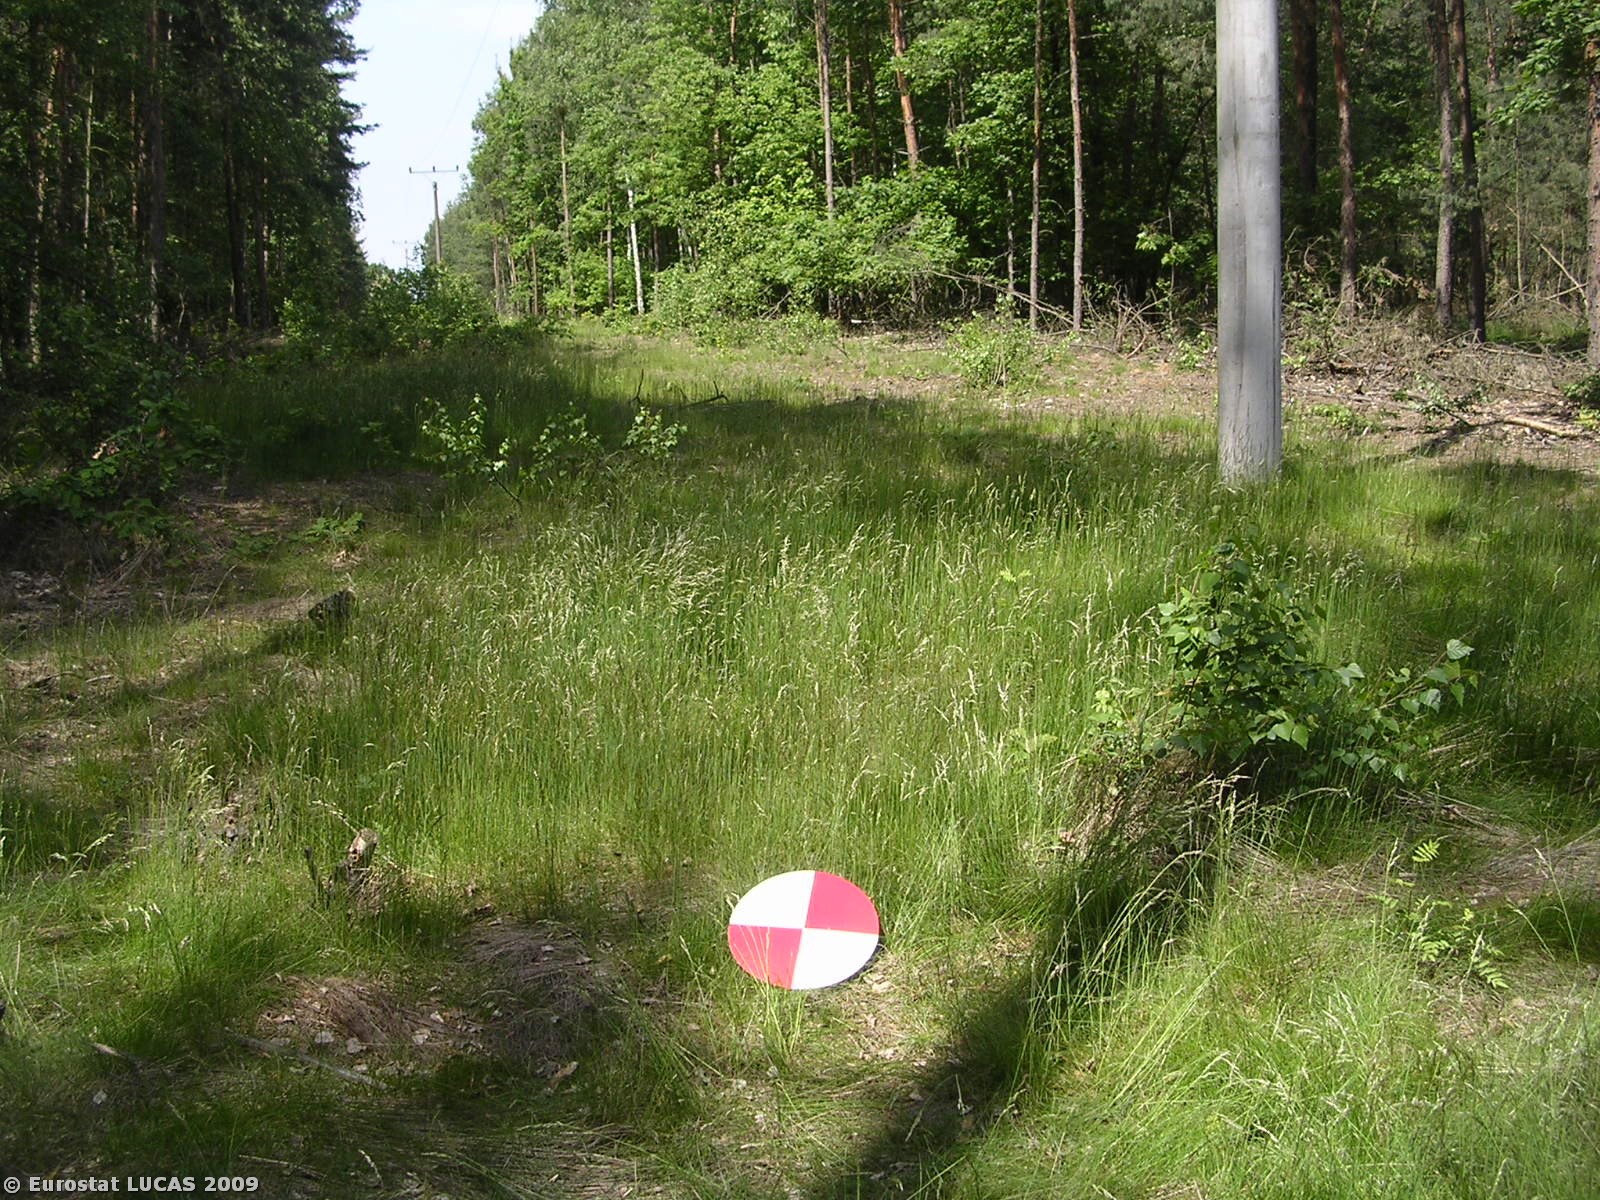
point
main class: Grassland
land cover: Grassland with sparse tree/shrub cover
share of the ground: > 75 %
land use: Forestry
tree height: > 5 m
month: May
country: CZ
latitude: 50.2315
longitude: 14.6984
